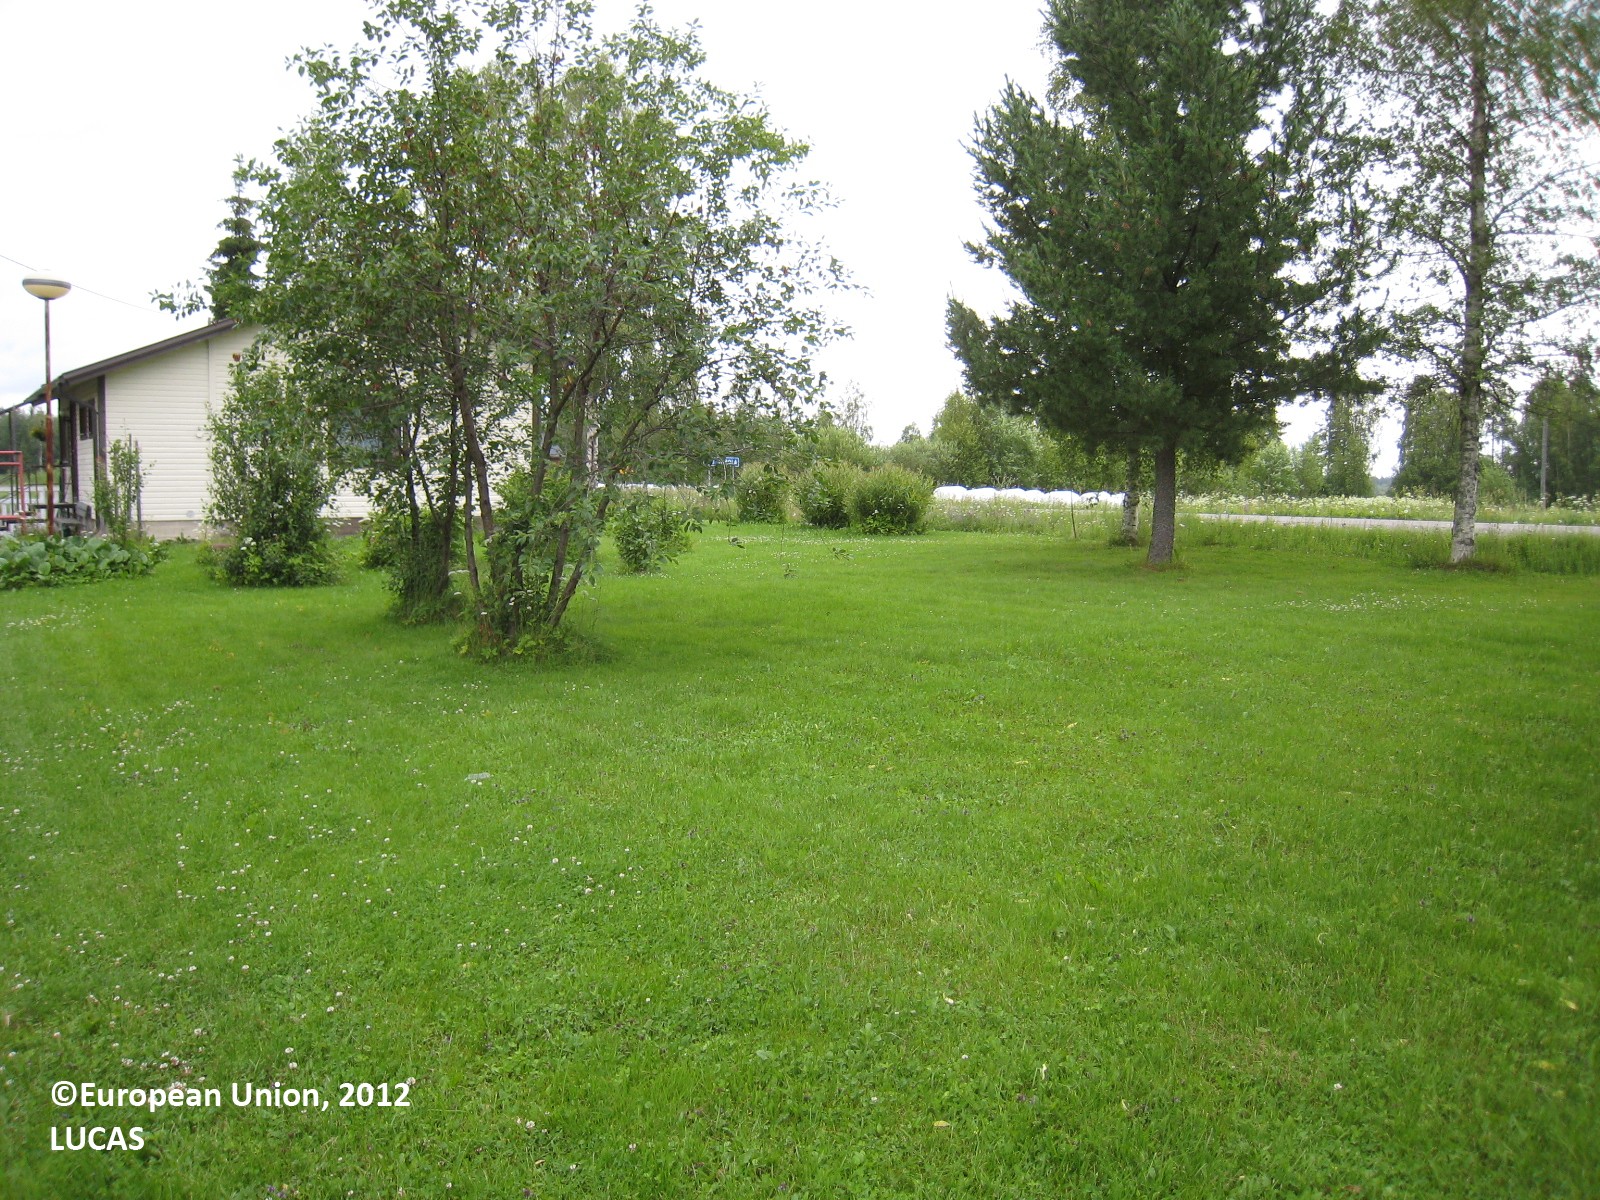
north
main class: Grassland
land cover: Grassland with sparse tree/shrub cover
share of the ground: > 75 %
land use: Residential
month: July
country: FI
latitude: 61.8284
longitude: 27.3922
